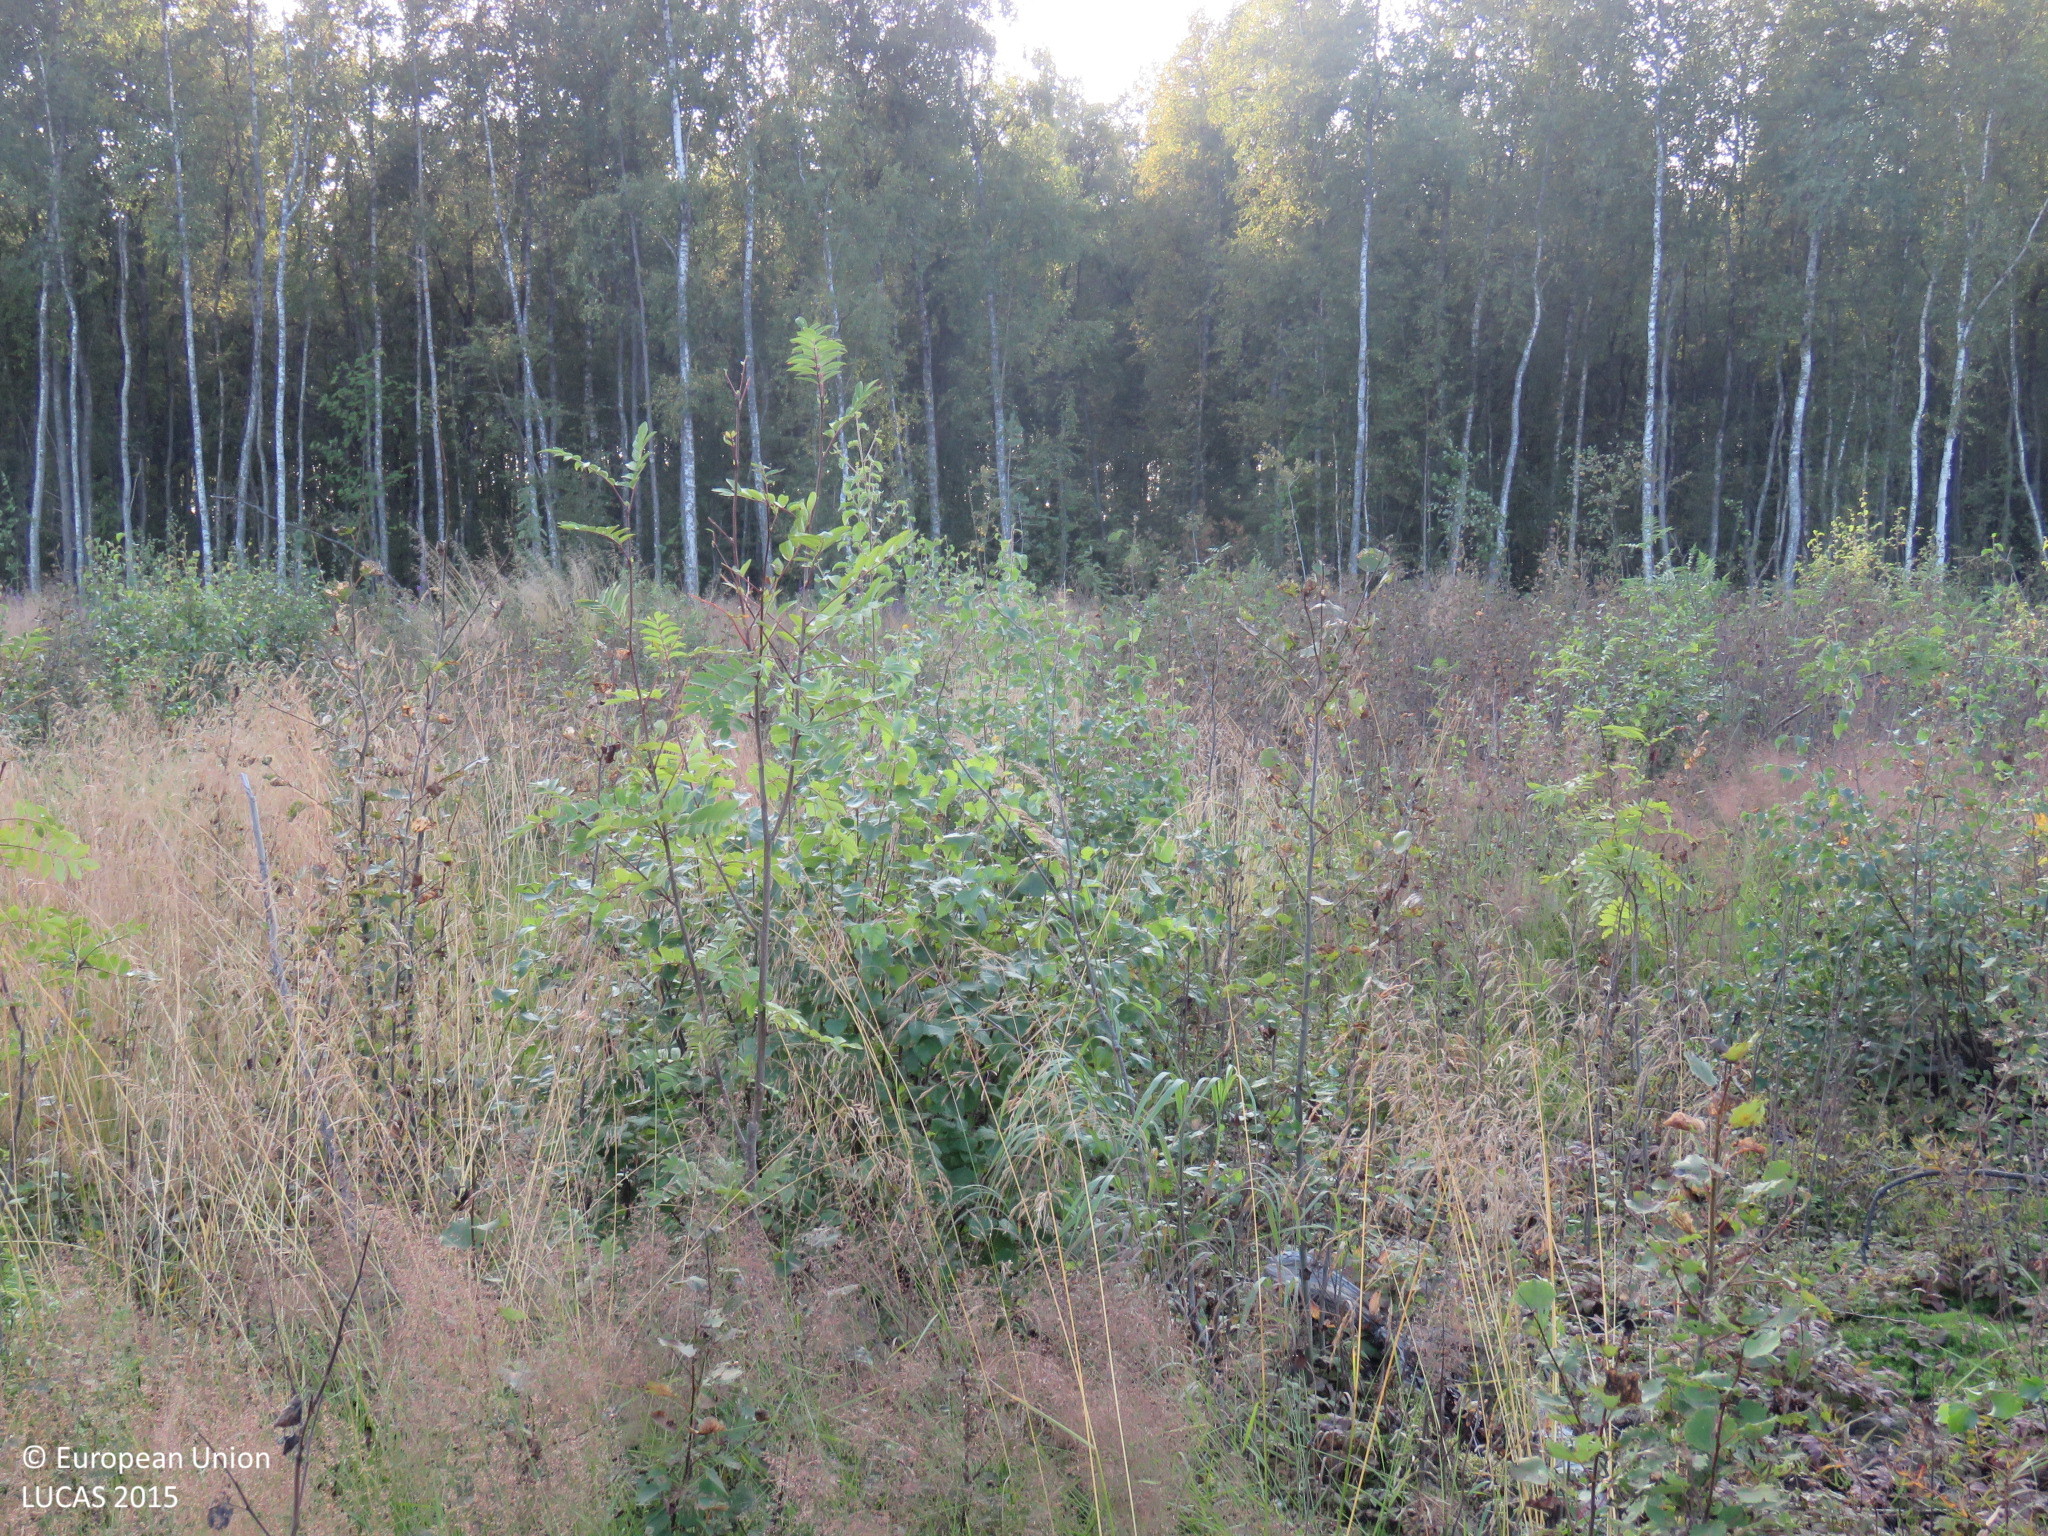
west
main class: Woodland
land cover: Broadleaved woodland
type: non-riverine alder, birch or aspen forest
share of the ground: 50 - 75 %
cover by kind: broadleaved forest trees 60 %, herbaceous plants 30 %, lichens and mosses 10 %
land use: Forestry
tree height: < 5 m
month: August
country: FI
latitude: 64.8756
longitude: 25.4297
